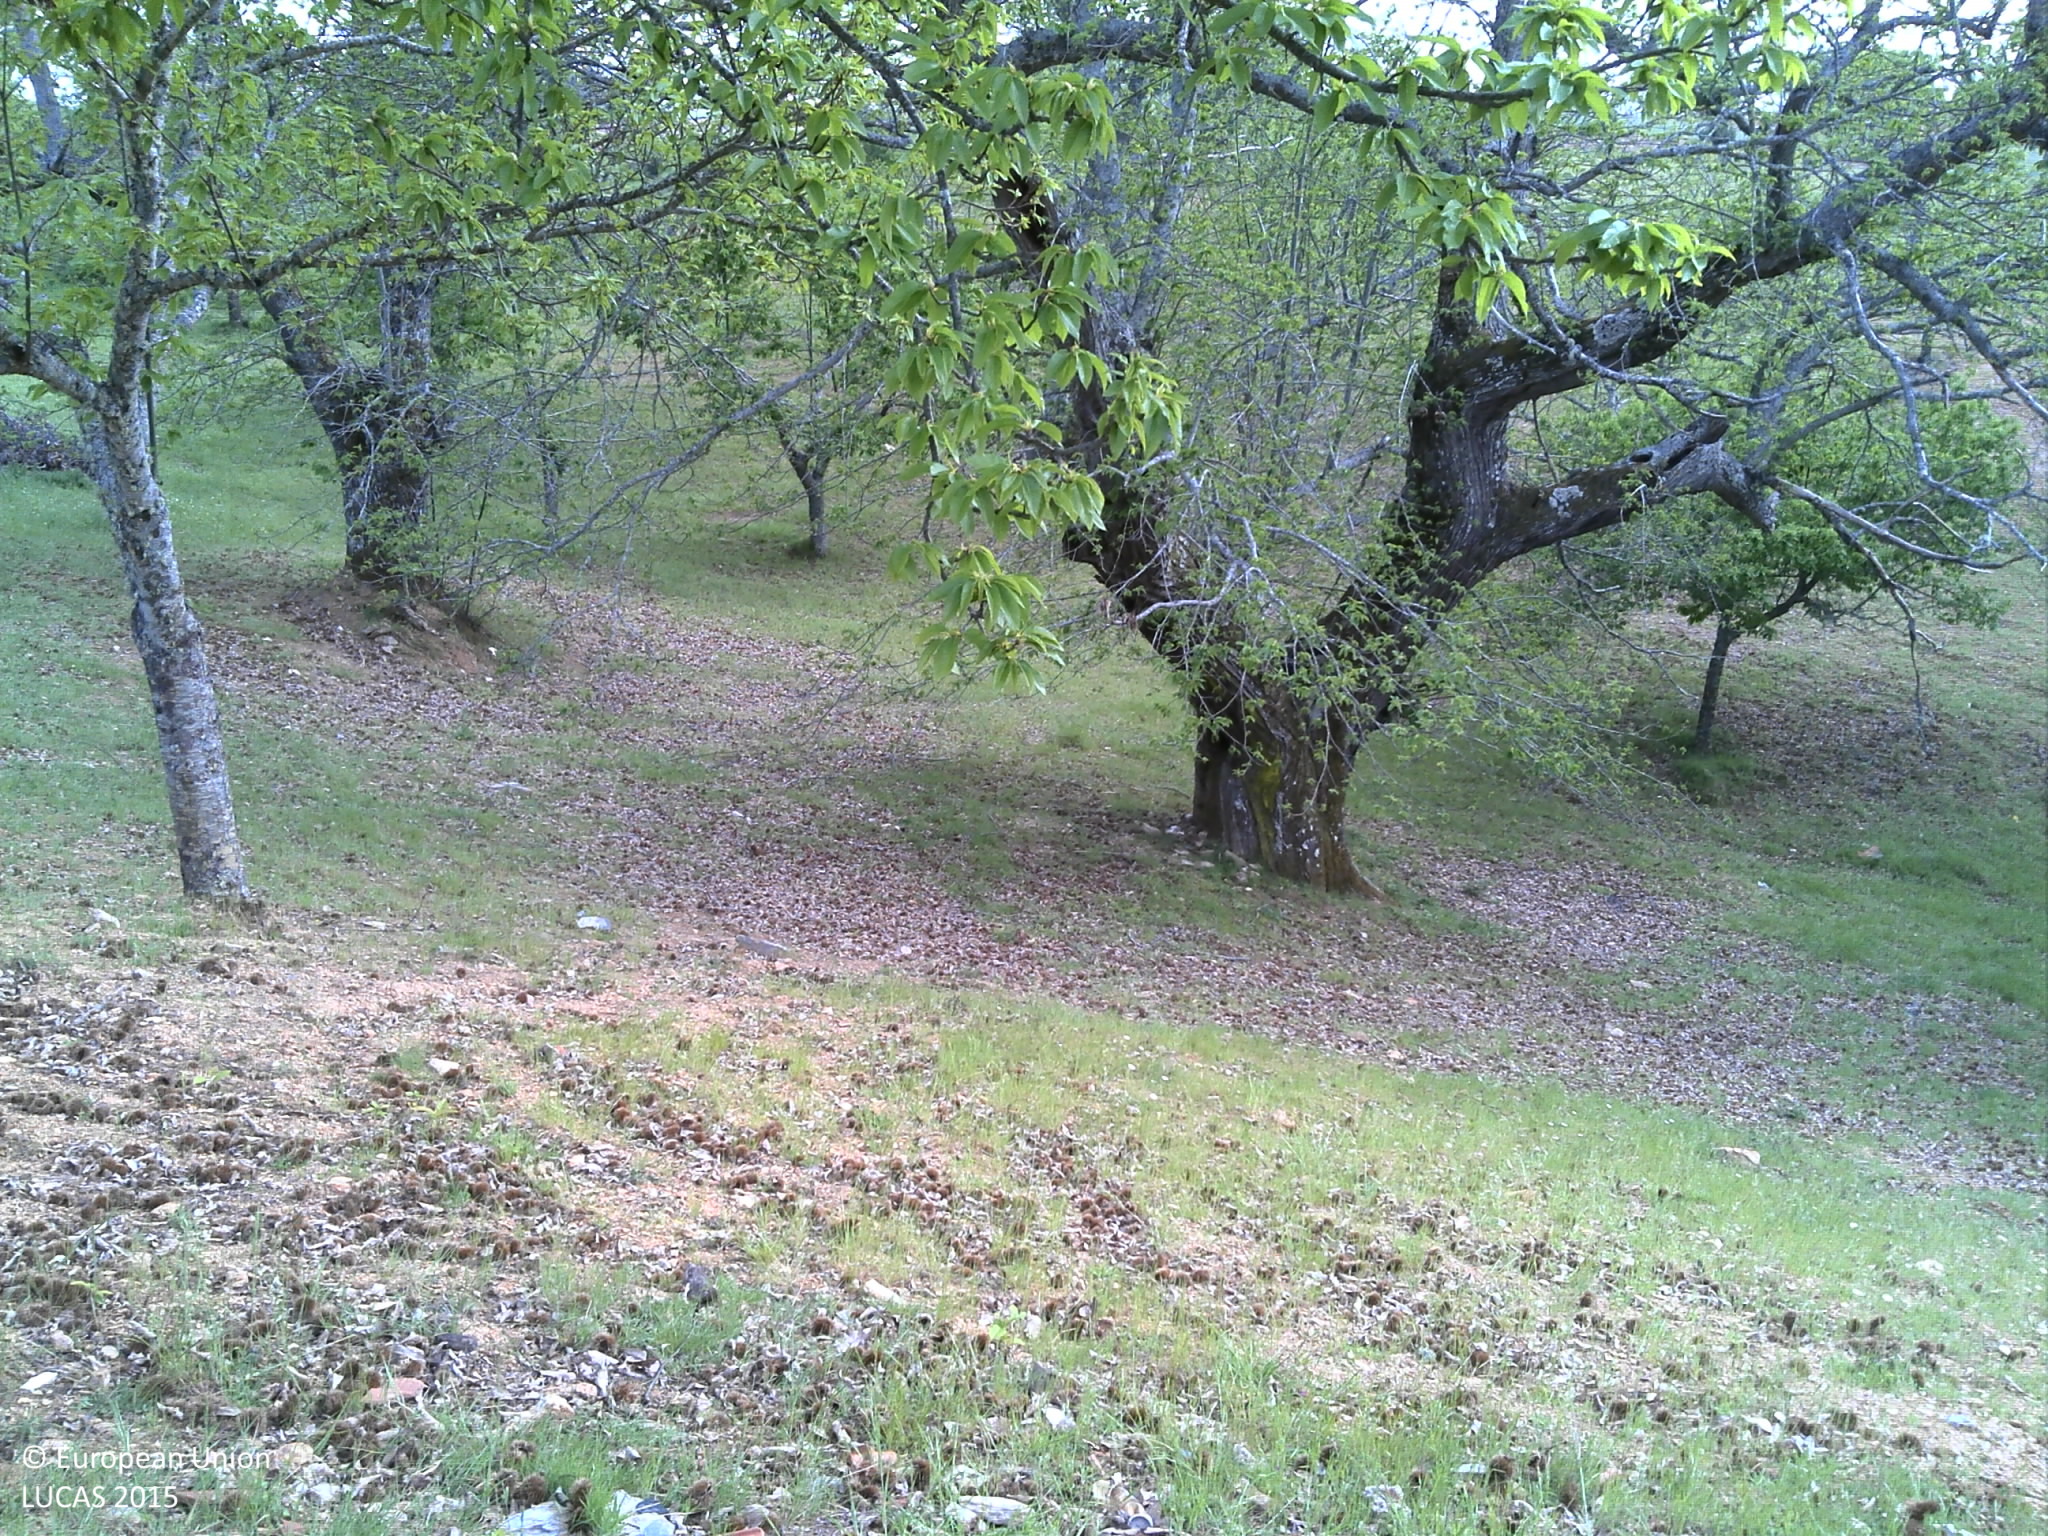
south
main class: Cropland
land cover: Nuts trees
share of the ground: 10 - 25 %
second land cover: Grassland without tree/shrub cover
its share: 25 - 50 %
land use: Agriculture (excluding fallow land and kitchen gardens)
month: May
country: PT
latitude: 41.9040
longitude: -7.1083
